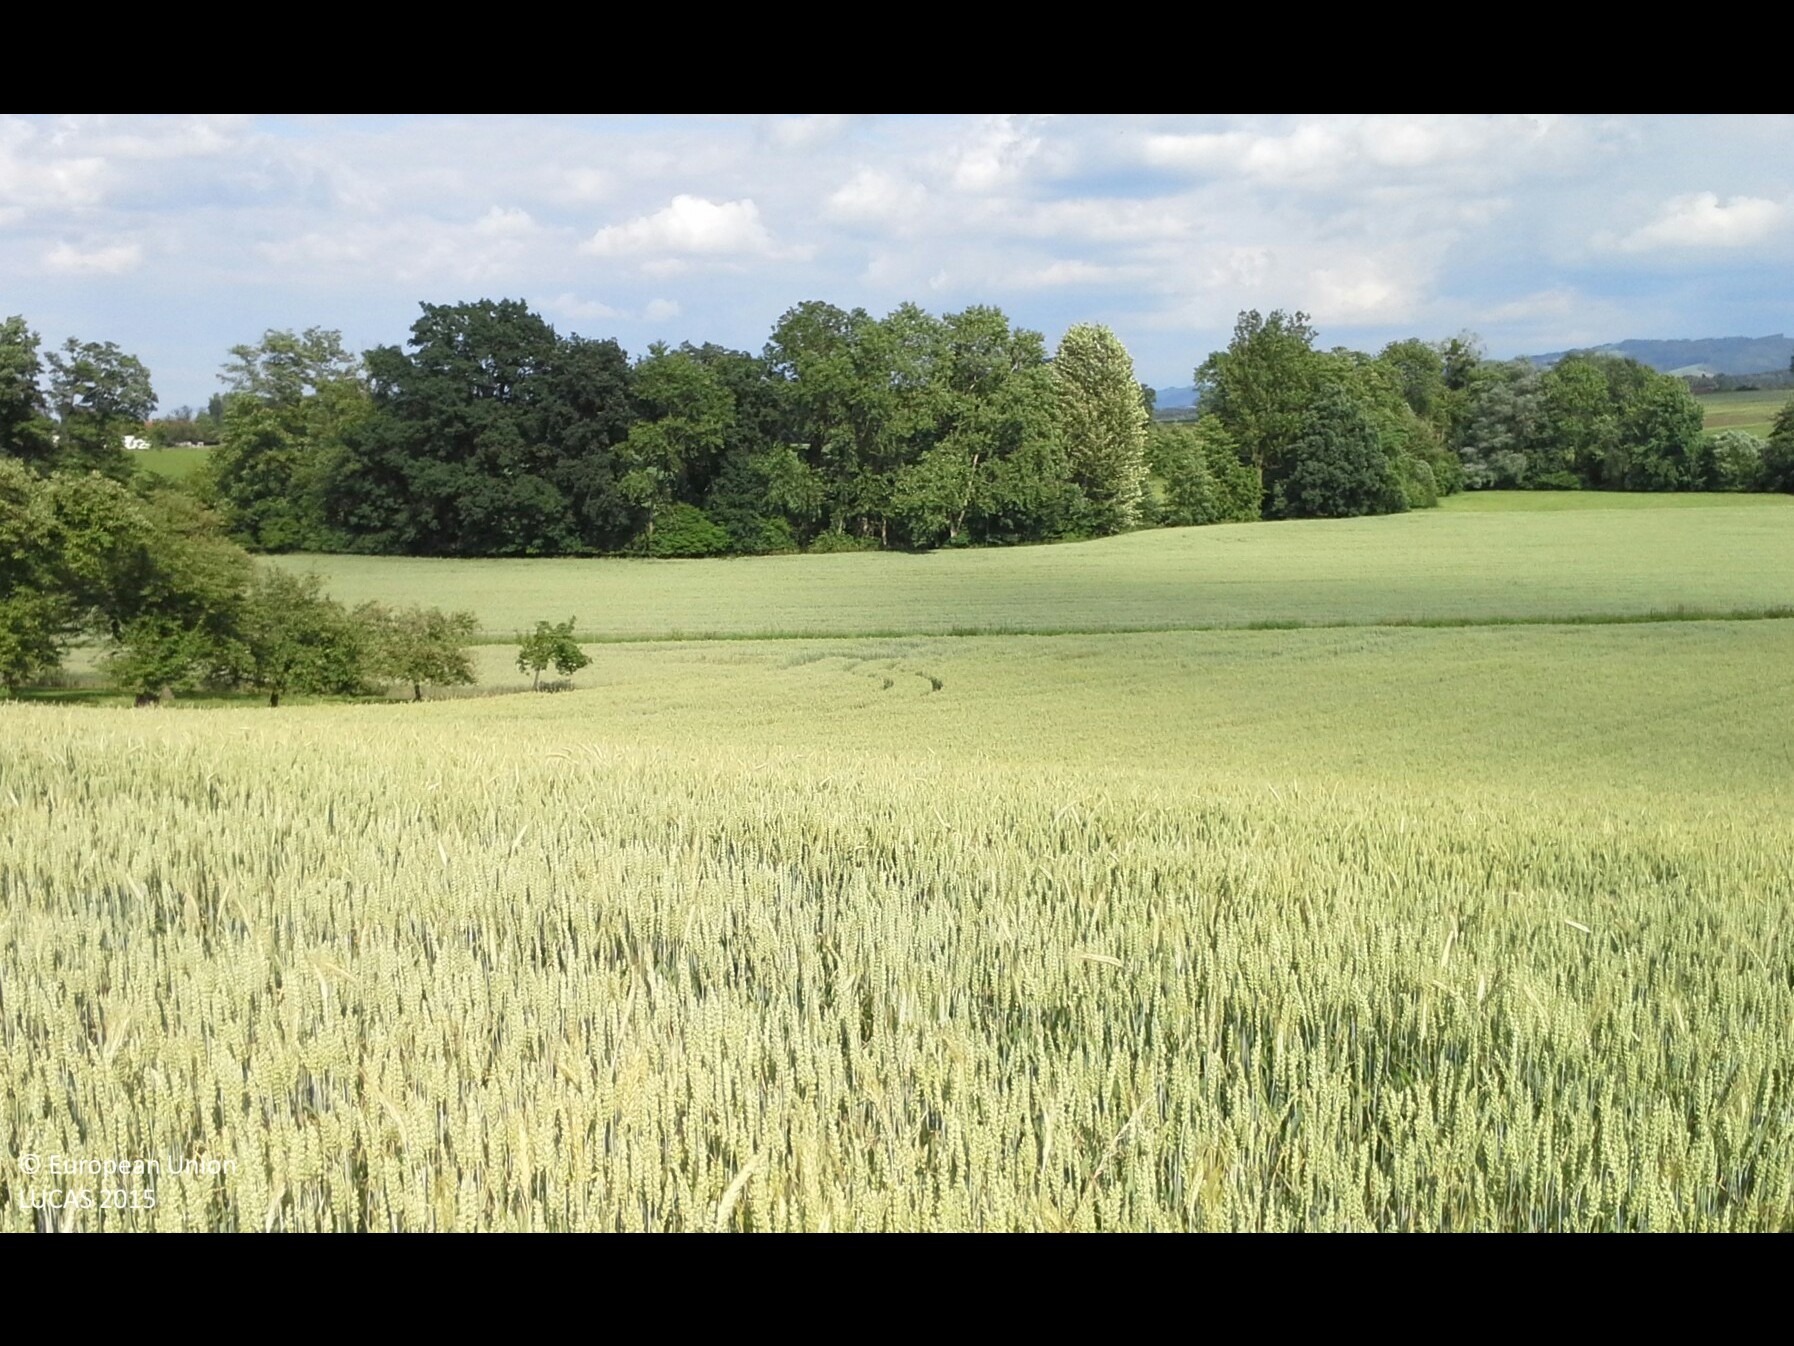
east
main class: Cropland
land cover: Common wheat
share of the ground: > 75 %
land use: Agriculture (excluding fallow land and kitchen gardens)
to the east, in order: Common wheat; Grass margins; Ditches and canals; Grass margins; Common wheat; Grass margins; Broadleaved woodland; Rivers and streams; Broadleaved woodland; Grass margins; Maize; Tracks; Maize
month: June
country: AT
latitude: 48.0509
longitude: 14.7093
